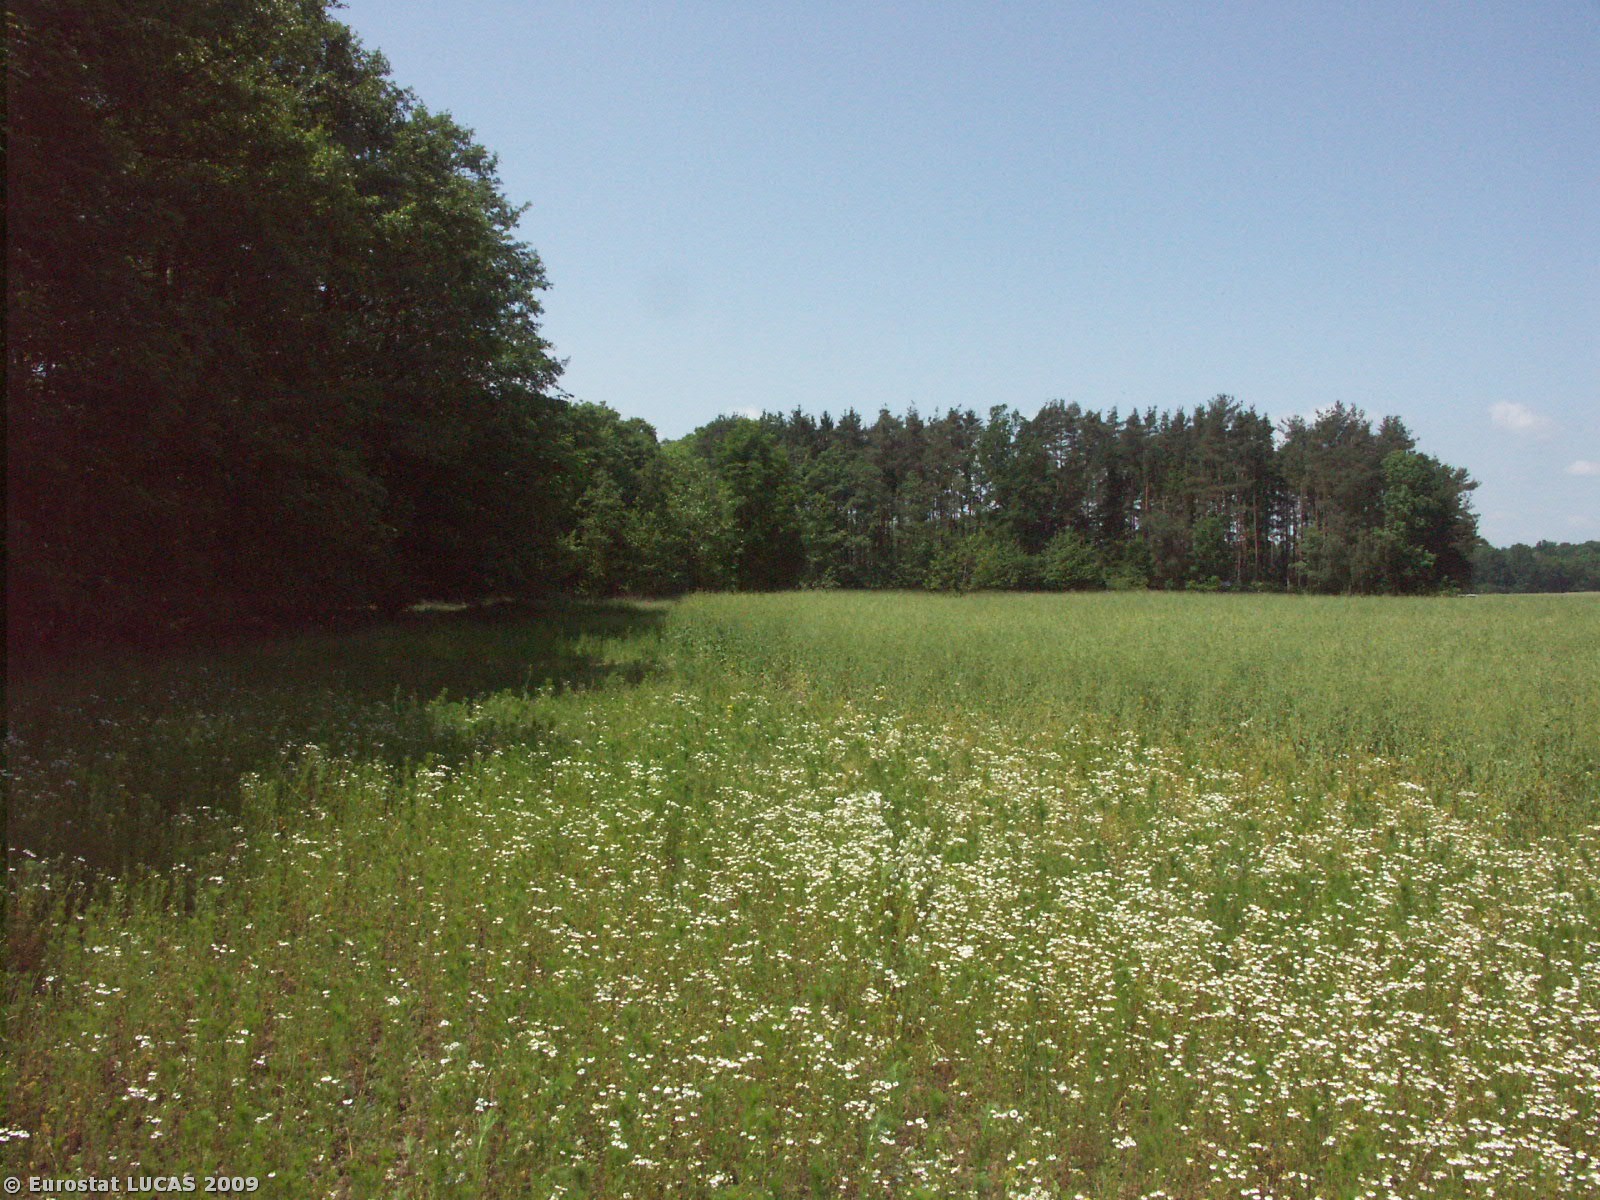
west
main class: Grassland
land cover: Spontaneously vegetated surfaces
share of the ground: > 75 %
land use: Fallow land
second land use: Nature reserves
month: May
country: CZ
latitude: 49.0966
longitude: 14.6991
